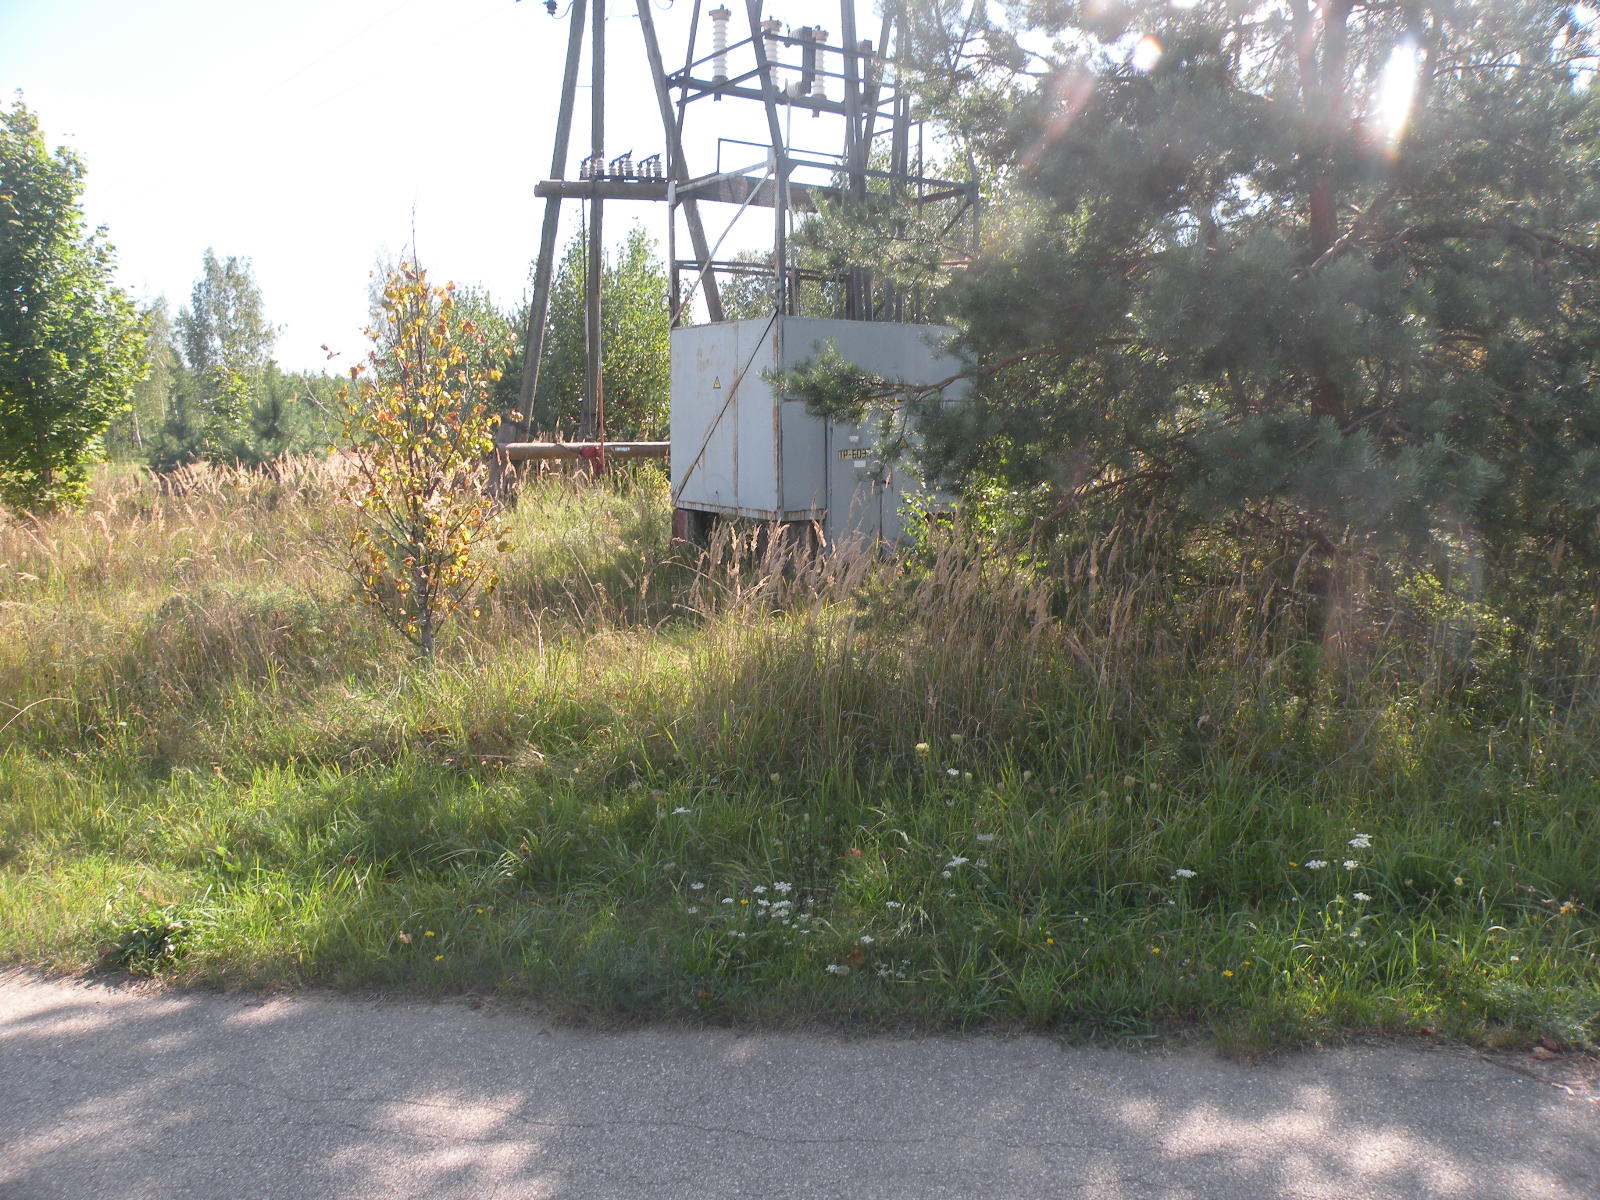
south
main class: Grassland
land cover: Grassland without tree/shrub cover
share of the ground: > 75 %
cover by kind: herbaceous plants 100 %
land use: Residential
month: September
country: LV
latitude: 55.9206
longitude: 26.6200
